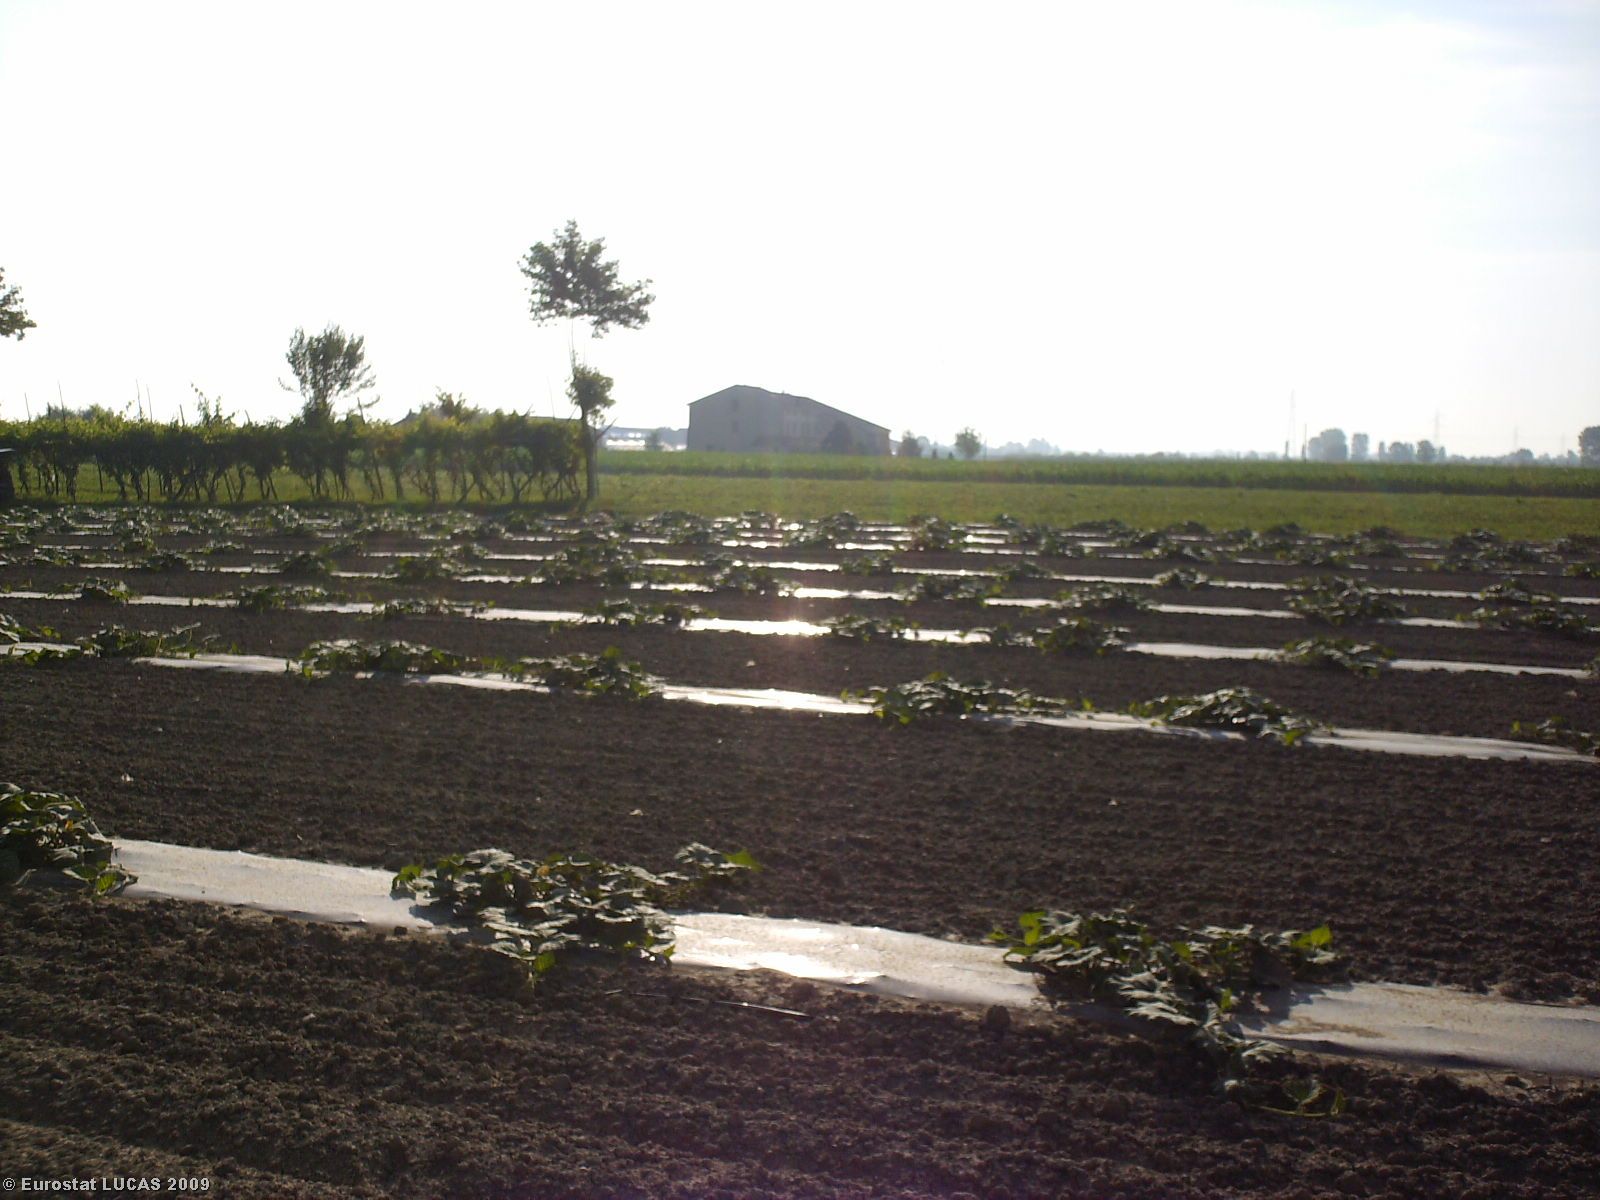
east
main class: Cropland
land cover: Other fresh vegetables
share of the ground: 25 - 50 %
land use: Agriculture (excluding fallow land and kitchen gardens)
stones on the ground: < 10 %
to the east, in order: Other fresh vegetables; Tracks; Soya; Maize; Grass margins; Ditches and canals; Grass margins; Paved roads, cycling and walking lanes; Electric lines; Grass margins; Ditches and canals; Tracks; Sugar beet
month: June
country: IT
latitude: 44.9441
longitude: 10.5692
